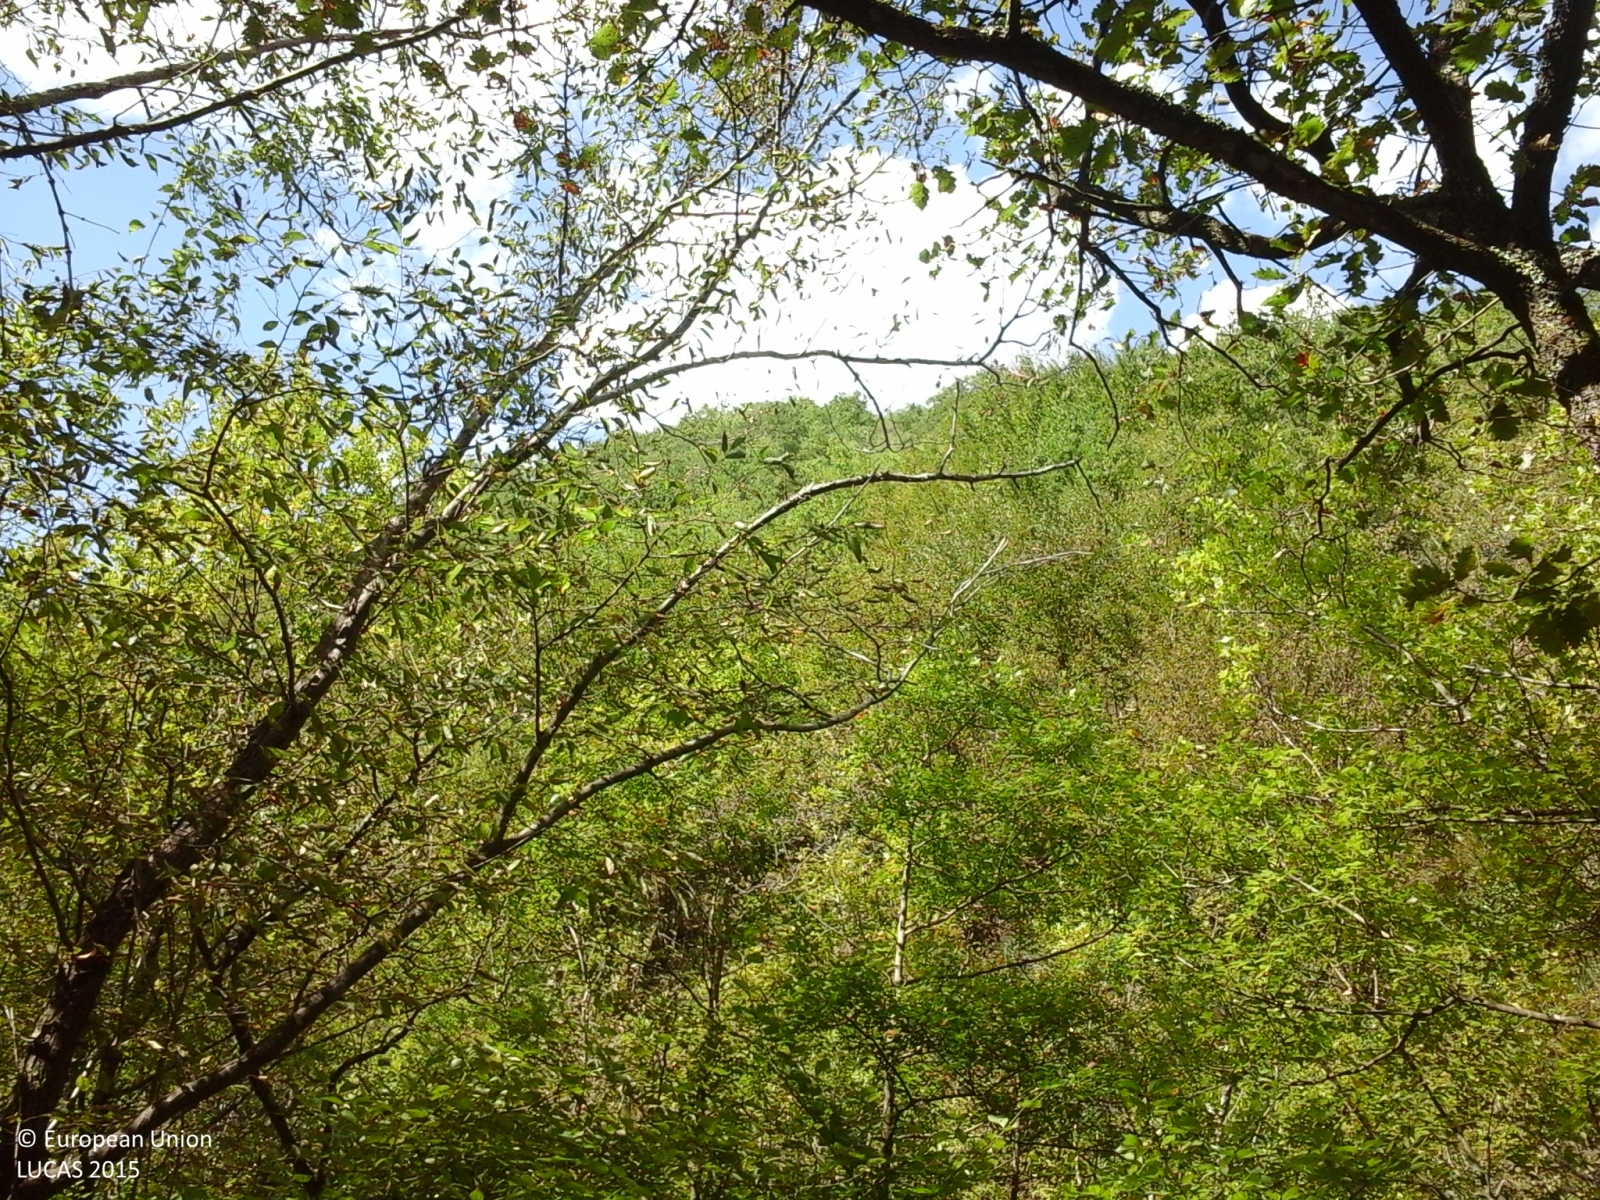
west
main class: Woodland
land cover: Broadleaved woodland
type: mesophytic deciduous forest
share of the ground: > 75 %
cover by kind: broadleaved forest trees 90 %, shrubs 10 %
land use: Forestry
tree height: > 5 m
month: September
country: IT
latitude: 43.2741
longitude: 13.1337
